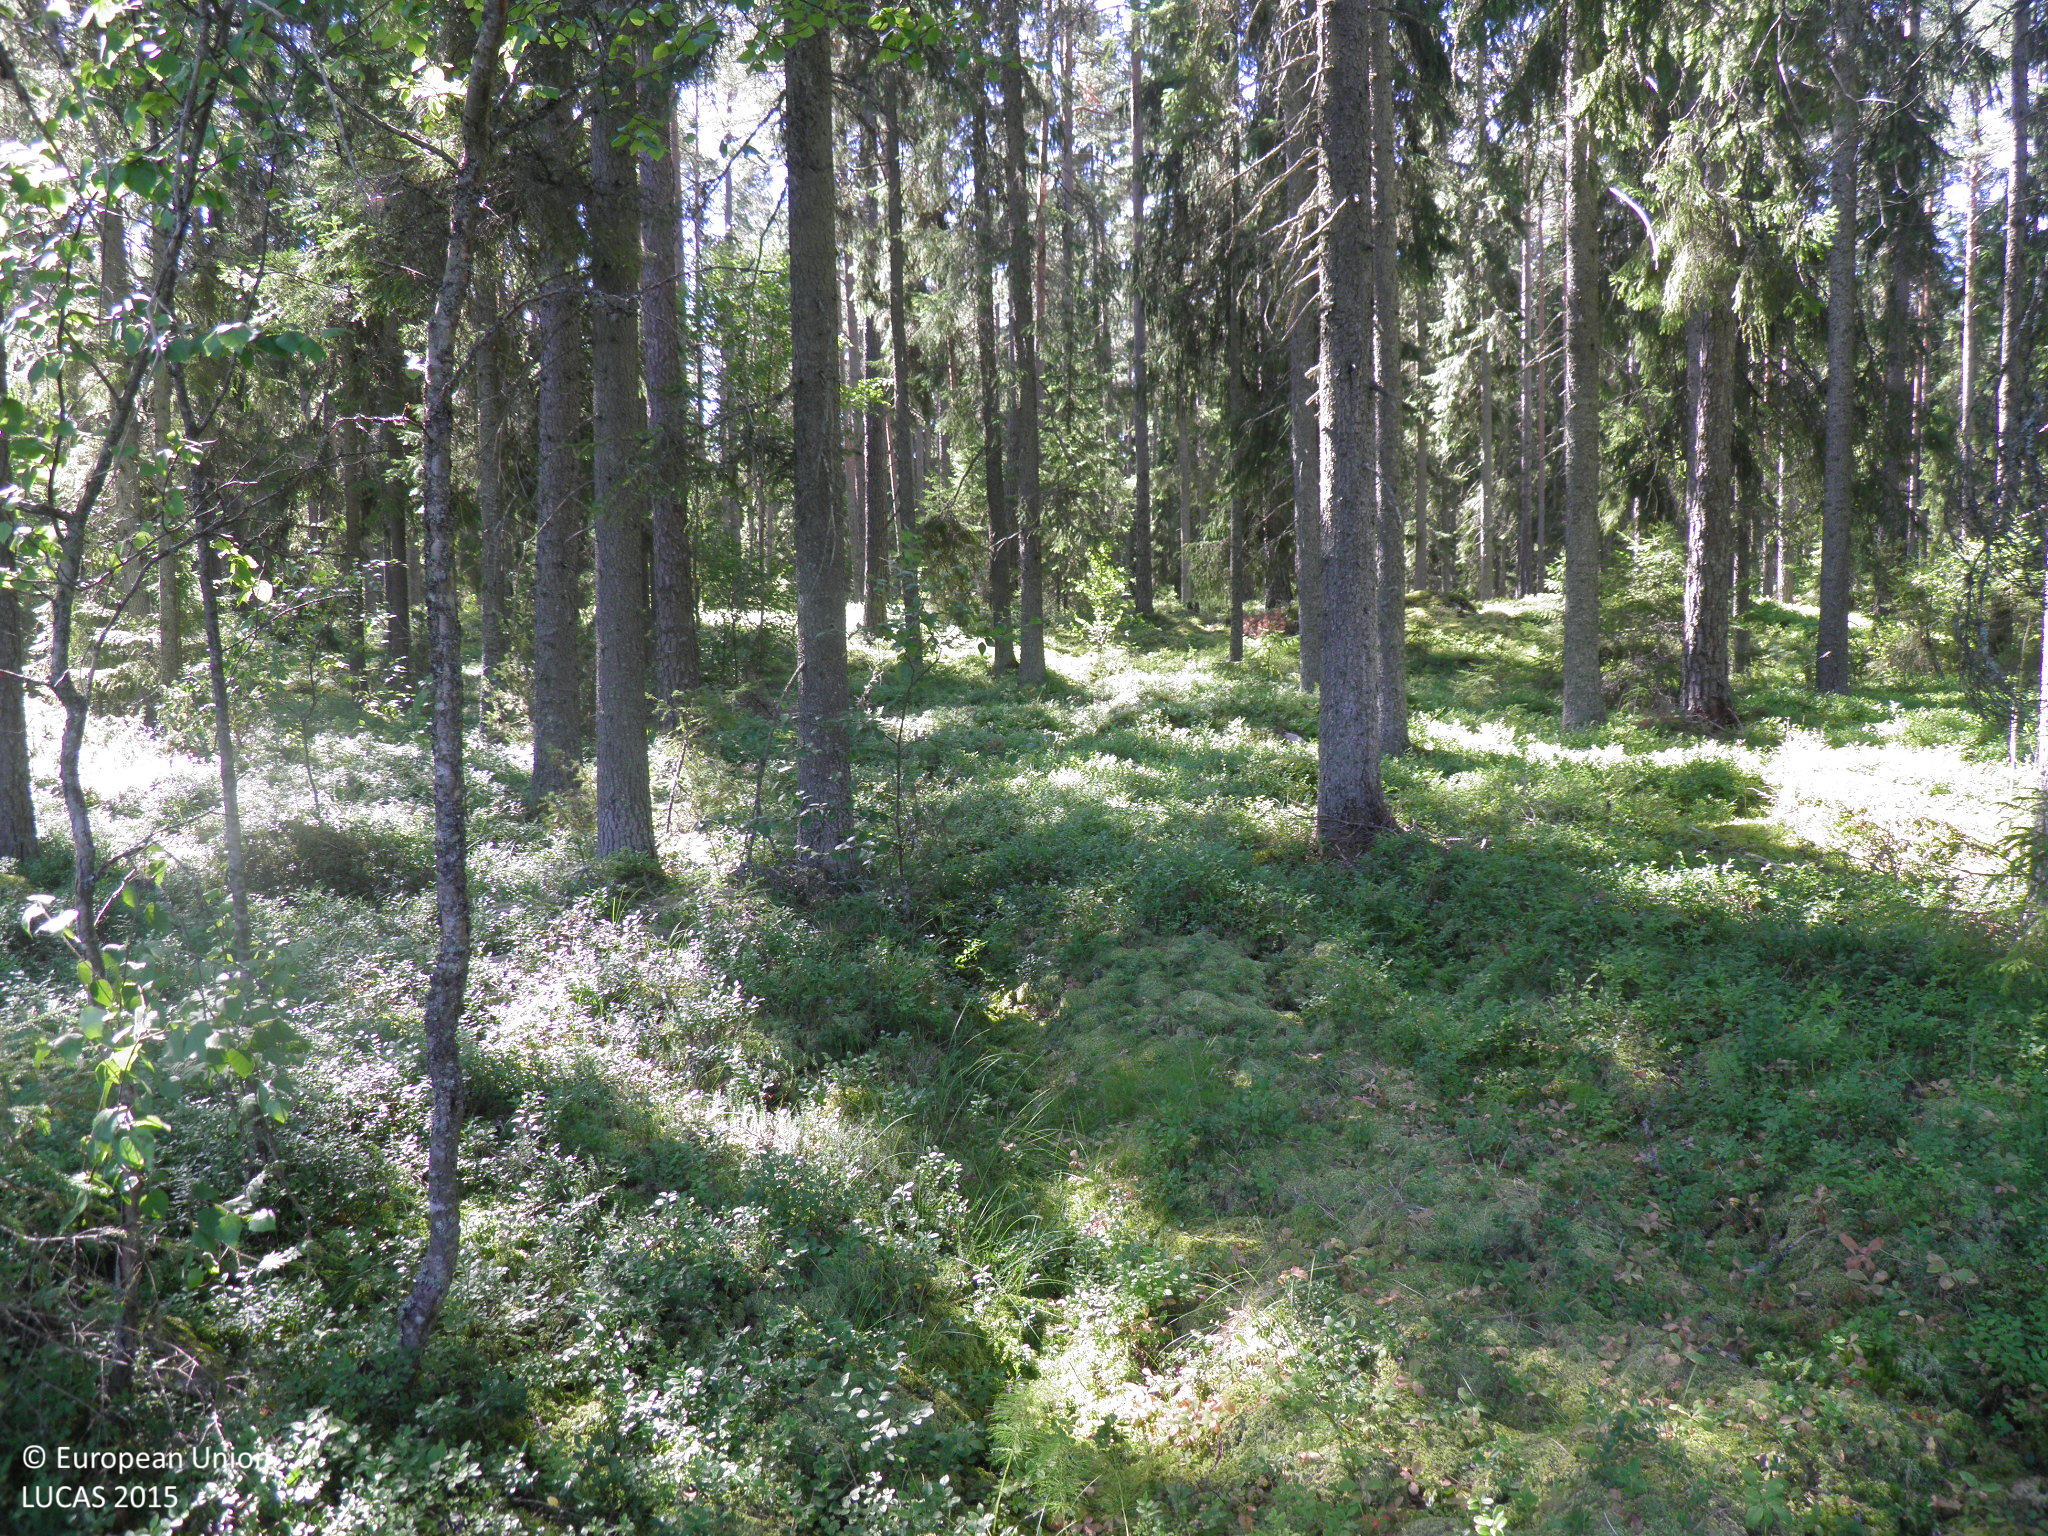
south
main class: Woodland
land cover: Spruce dominated coniferous woodland
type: hemiboreal forest and nemoral coniferous forest and mixed broadleaved-coniferous forest
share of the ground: > 75 %
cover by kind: coniferous forest trees 75 %, shrubs 25 %
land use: Forestry
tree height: > 5 m
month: August
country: FI
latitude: 60.7753
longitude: 21.6056
